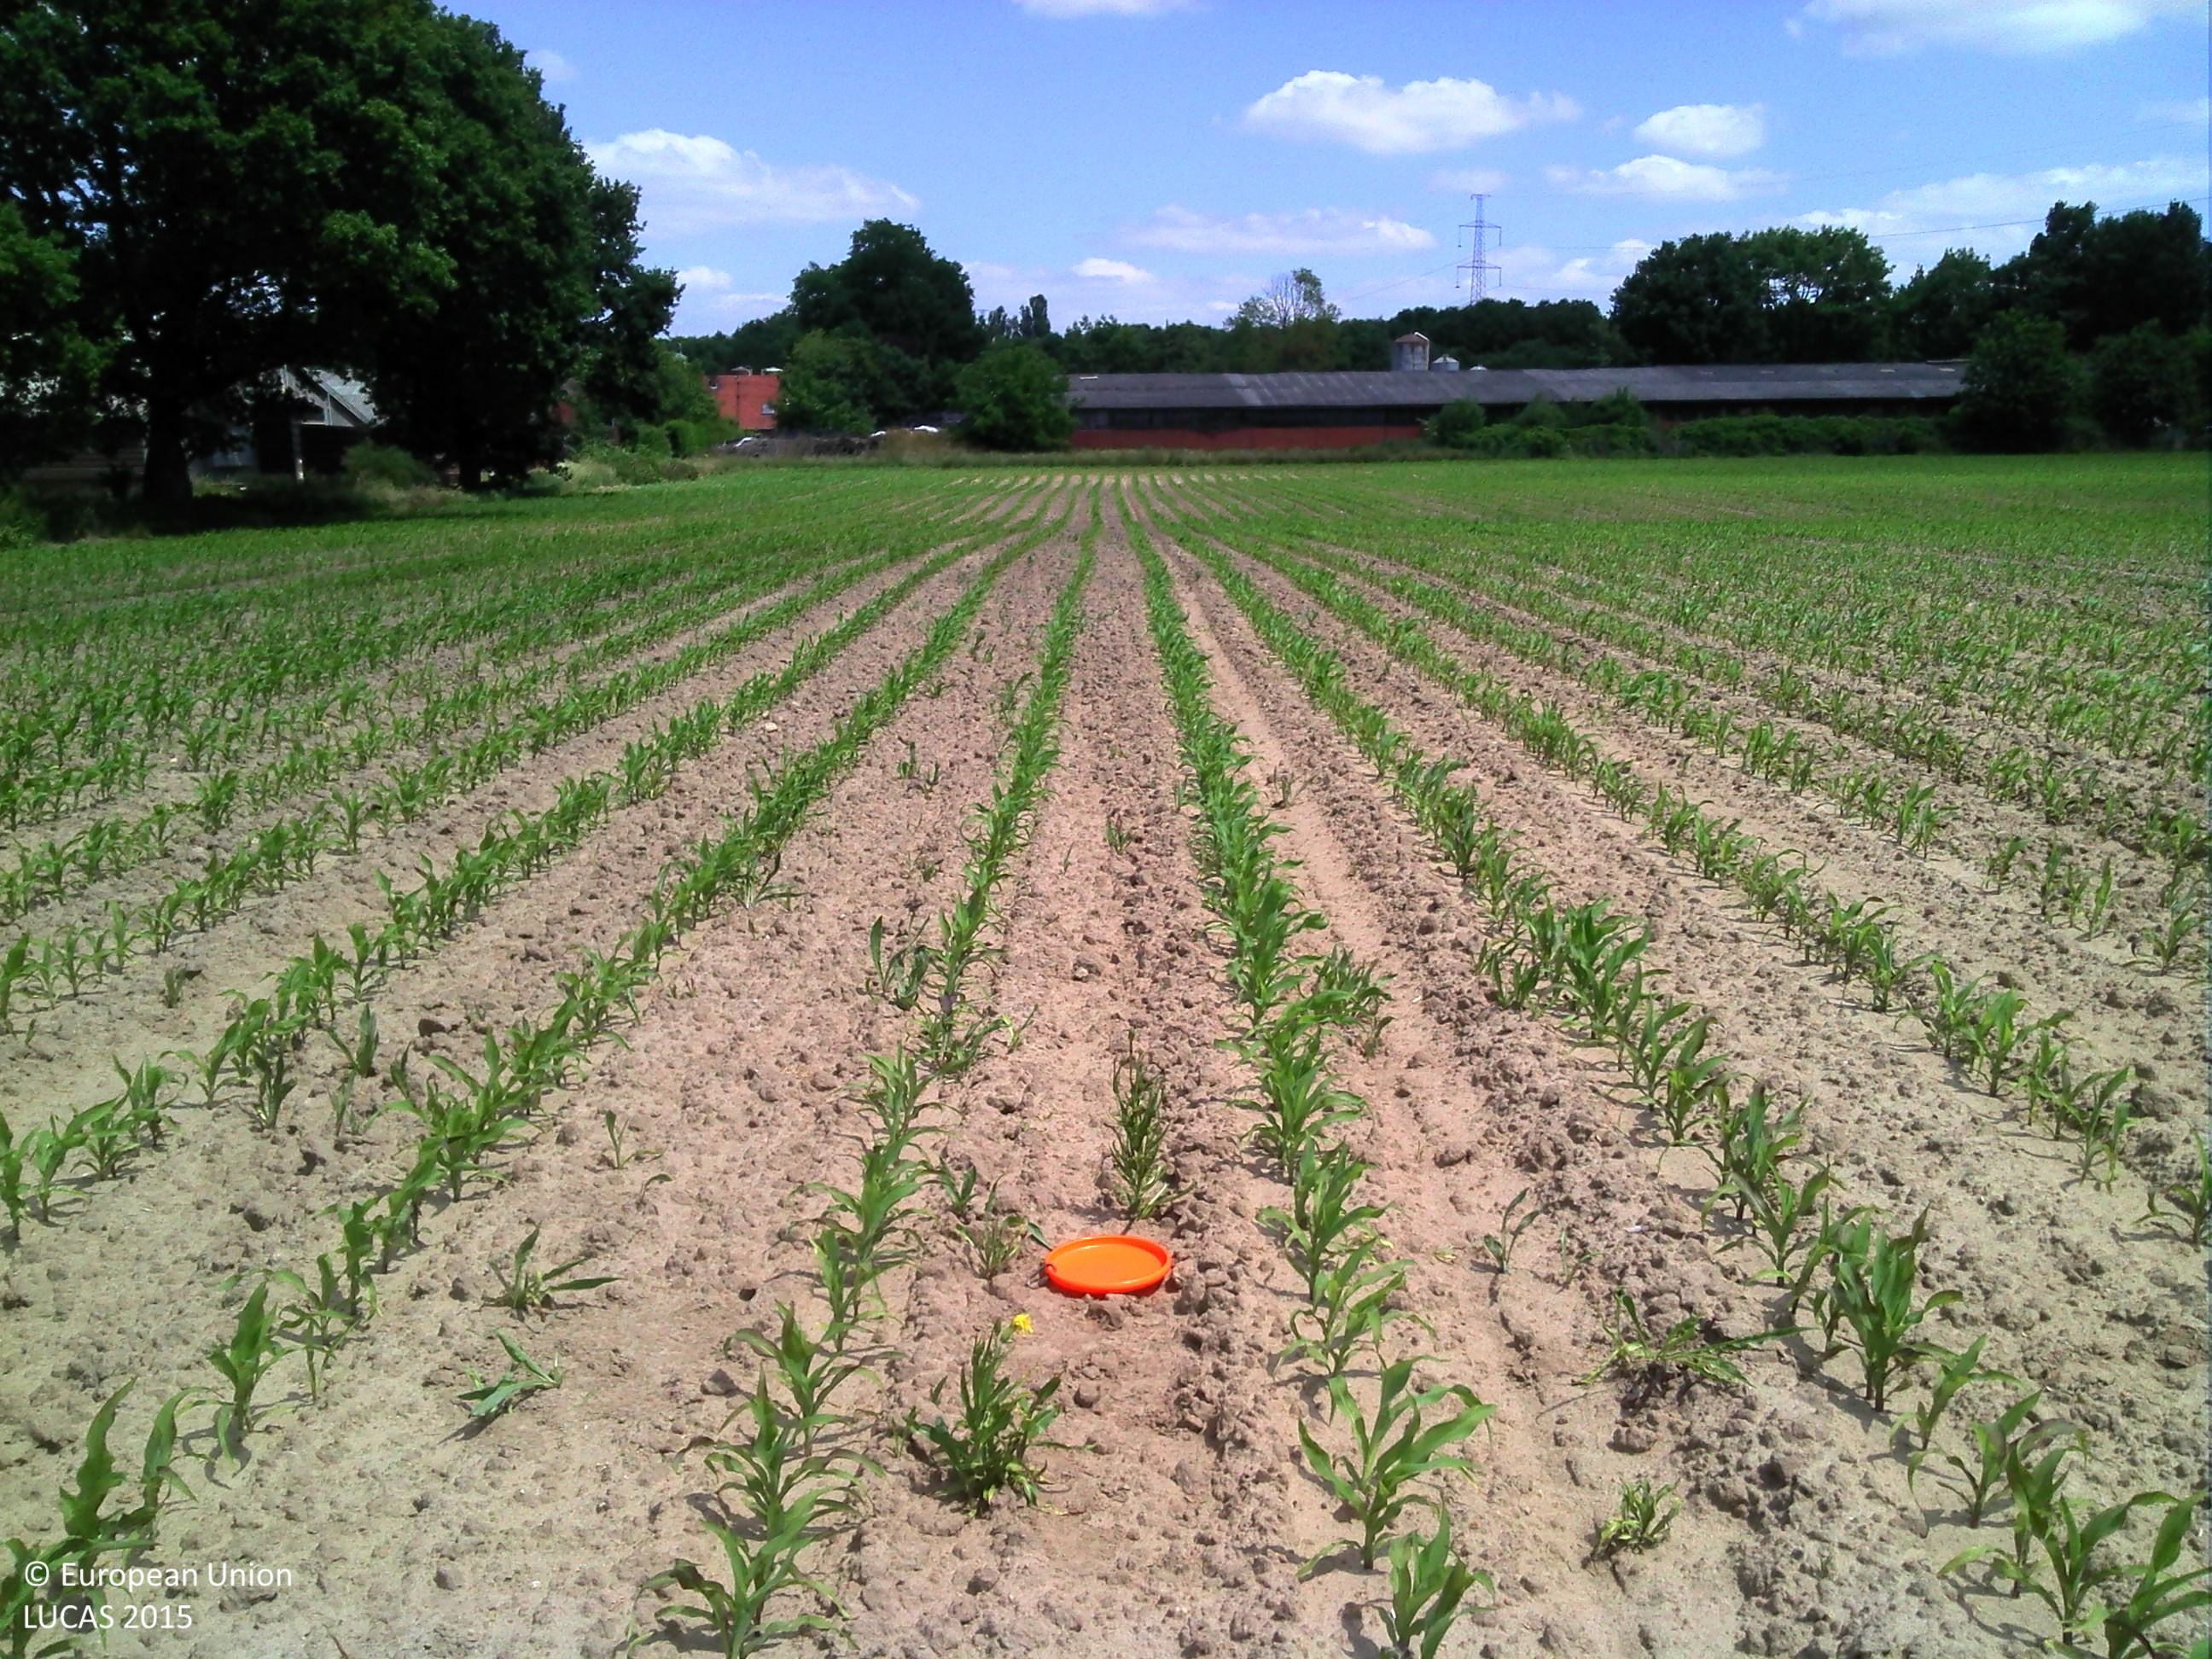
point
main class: Cropland
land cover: Maize
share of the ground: 10 - 25 %
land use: Agriculture (excluding fallow land and kitchen gardens)
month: June
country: BE
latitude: 51.1136
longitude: 5.7560
